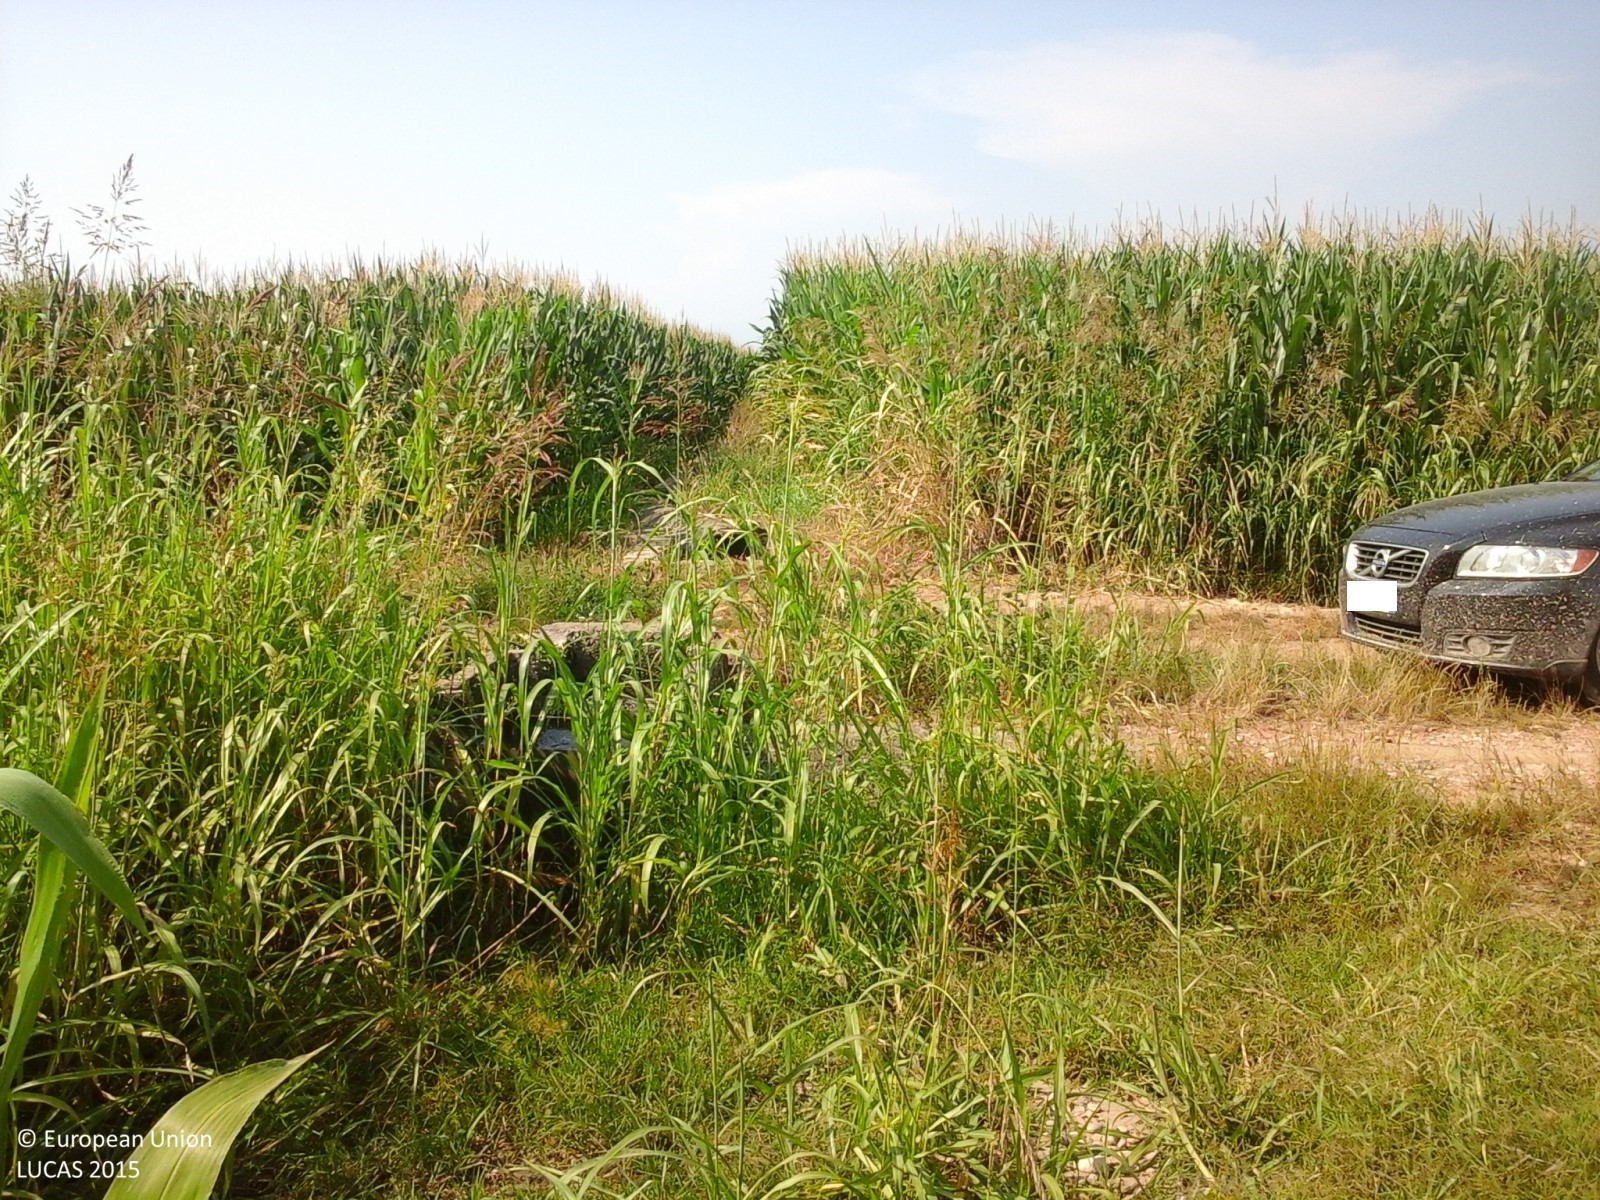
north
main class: Cropland
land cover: Maize
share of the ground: > 75 %
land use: Agriculture (excluding fallow land and kitchen gardens)
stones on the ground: < 10 %
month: July
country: IT
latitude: 45.3207
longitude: 10.8532
